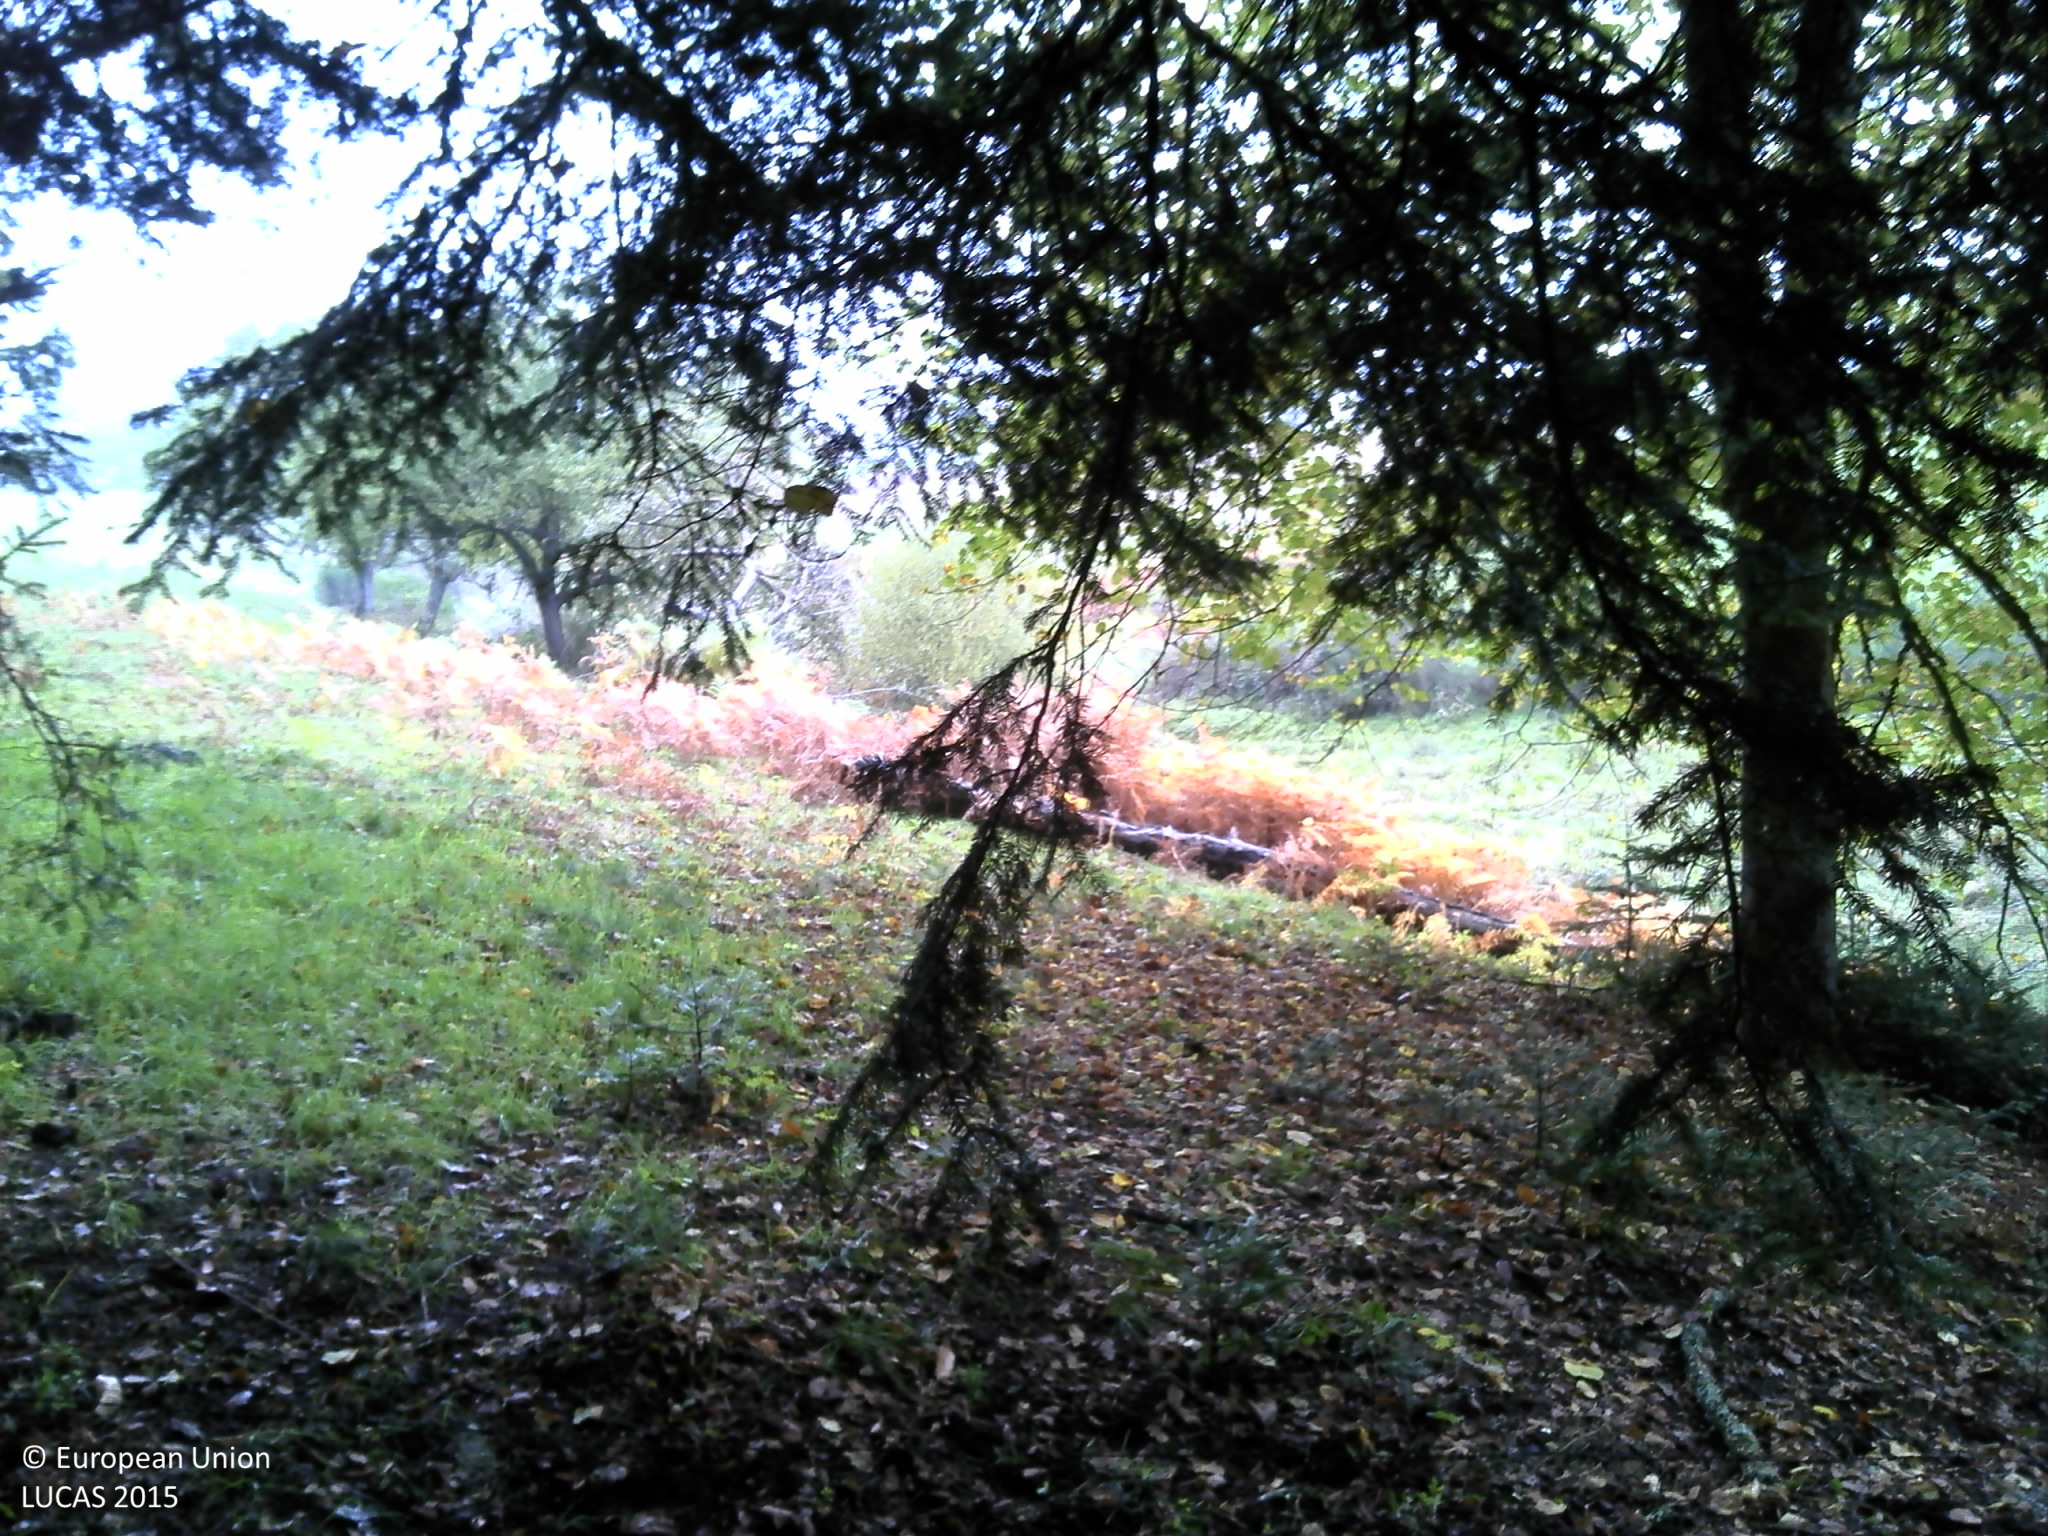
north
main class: Woodland
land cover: Spruce dominated mixed woodland
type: acidophilous oak and oak-birch forest
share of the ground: > 75 %
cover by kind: coniferous forest trees 60 %, broadleaved forest trees 30 %, unconsolidated bare surface 10 %
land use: Forestry
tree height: > 5 m
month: October
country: FR
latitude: 45.6596
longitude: 3.7004
